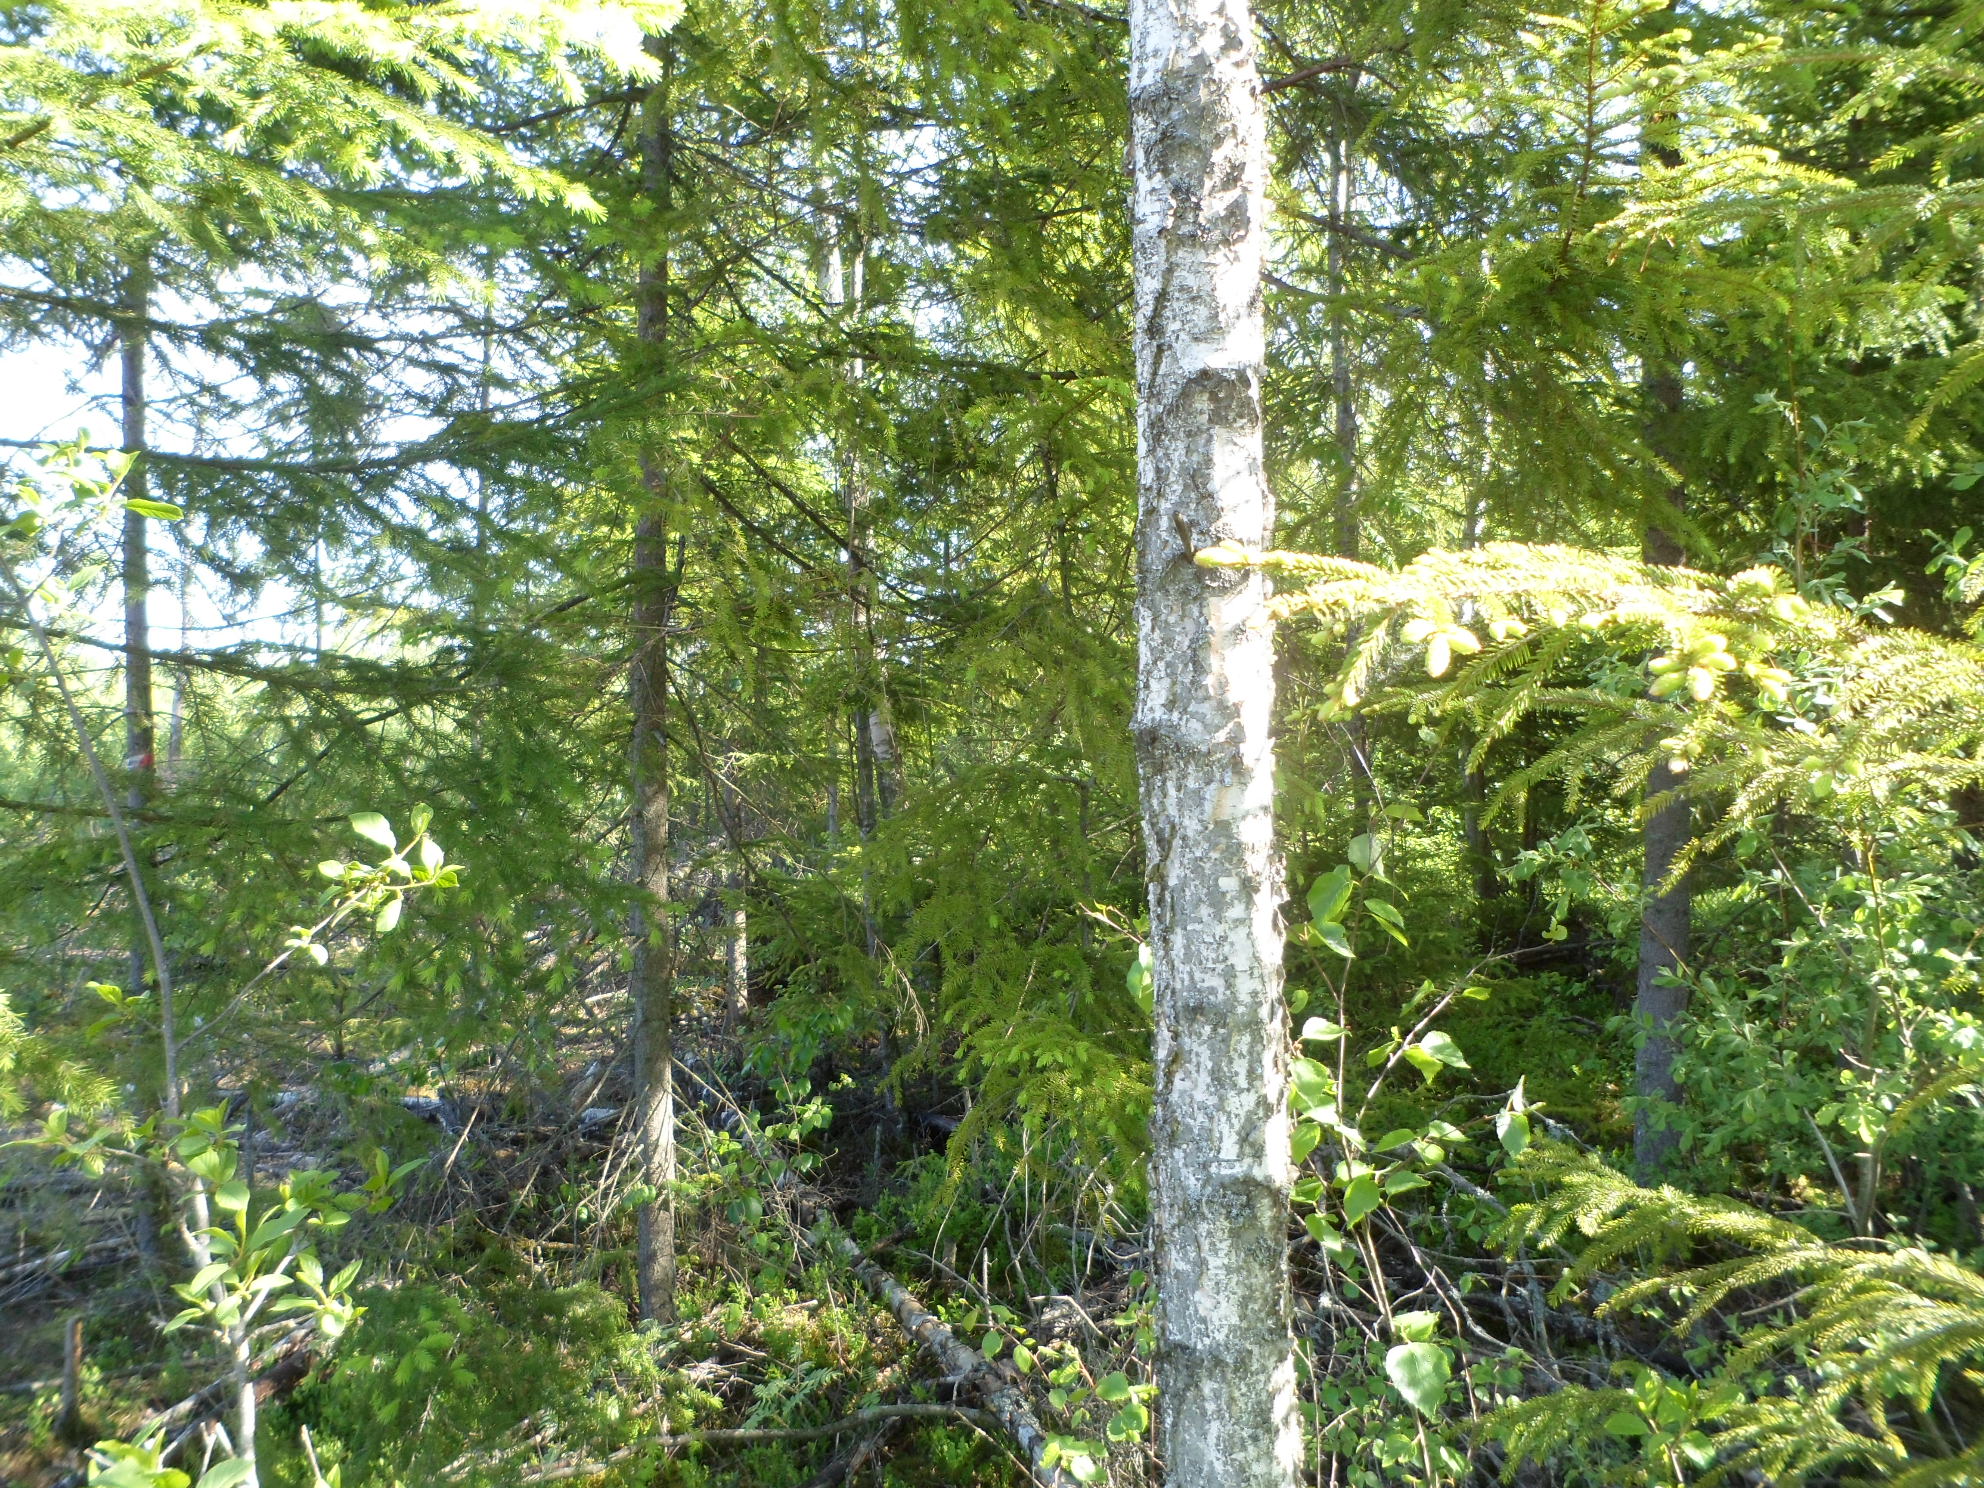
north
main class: Woodland
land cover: Spruce dominated mixed woodland
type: boreal forest
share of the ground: 50 - 75 %
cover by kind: coniferous forest trees 30 %, broadleaved forest trees 30 %, shrubs 25 %, lichens and mosses 10 %, herbaceous plants 5 %
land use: Forestry
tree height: > 5 m
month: June
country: SE
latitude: 56.8879
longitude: 14.8720
